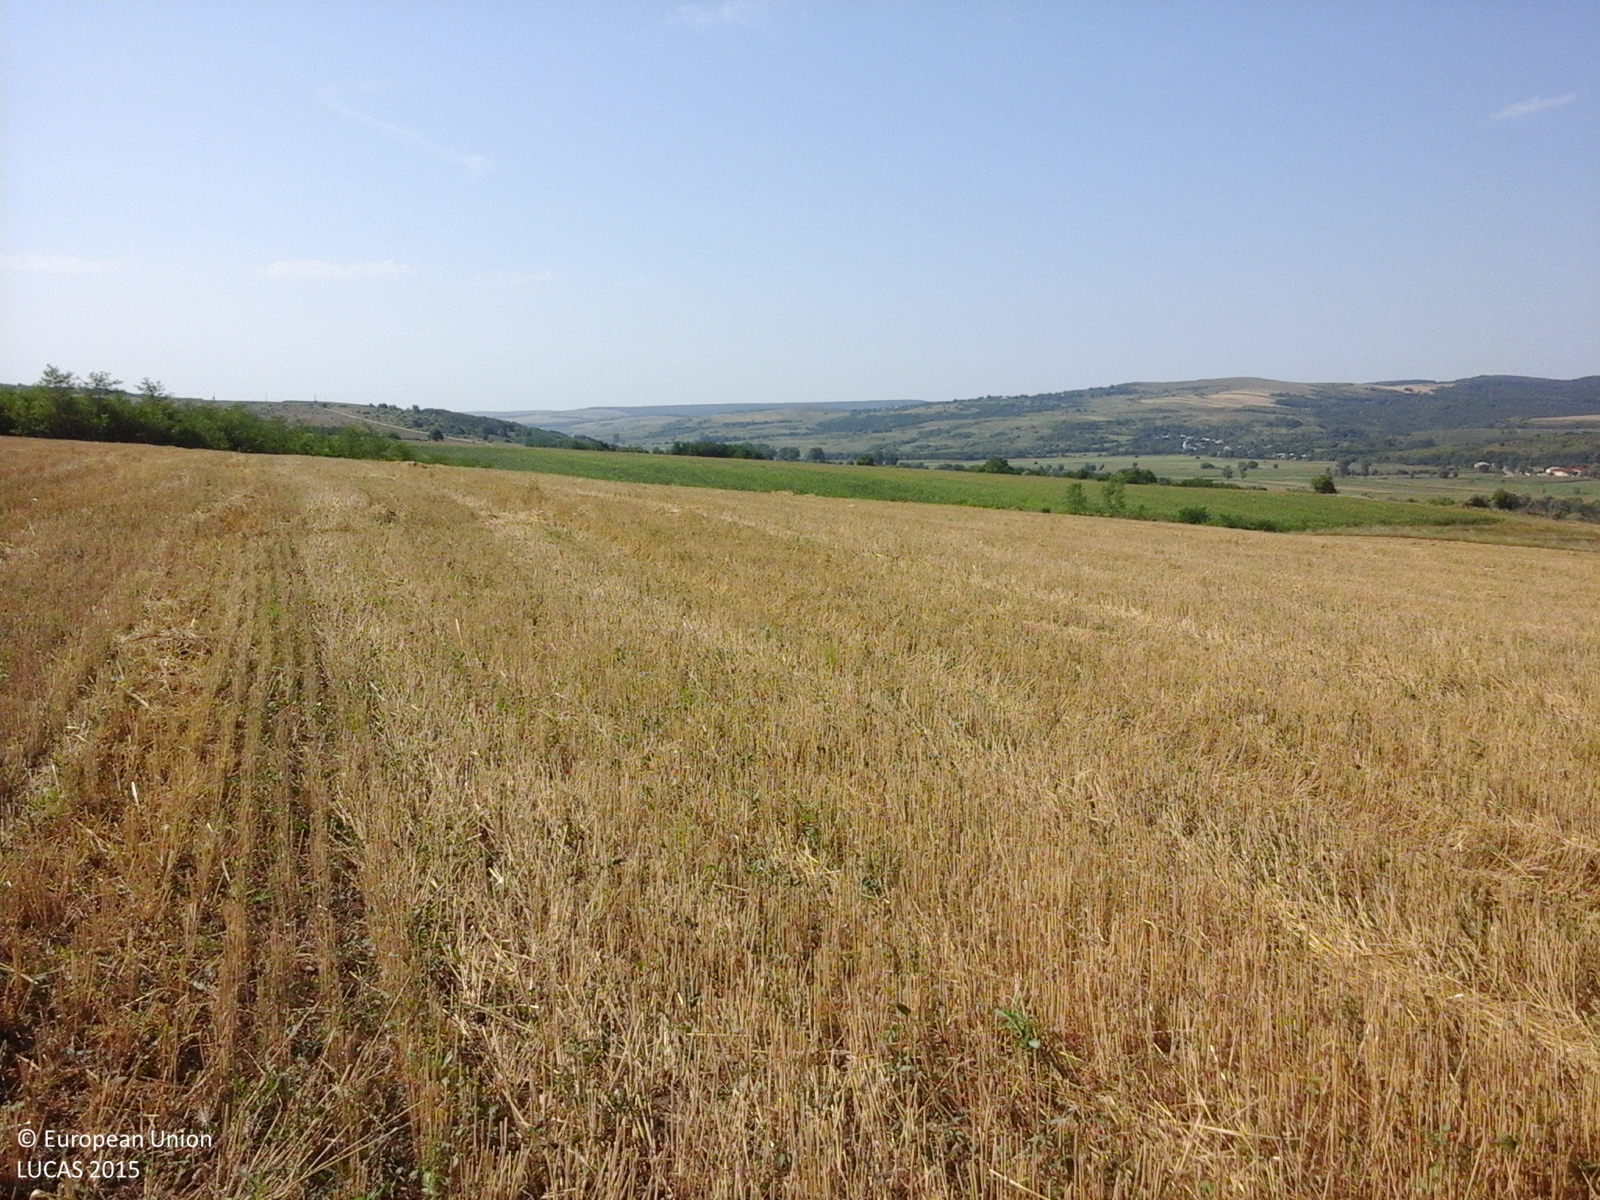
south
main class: Cropland
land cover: Common wheat
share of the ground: > 75 %
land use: Agriculture (excluding fallow land and kitchen gardens)
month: July
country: RO
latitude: 46.1762
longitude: 27.3180
